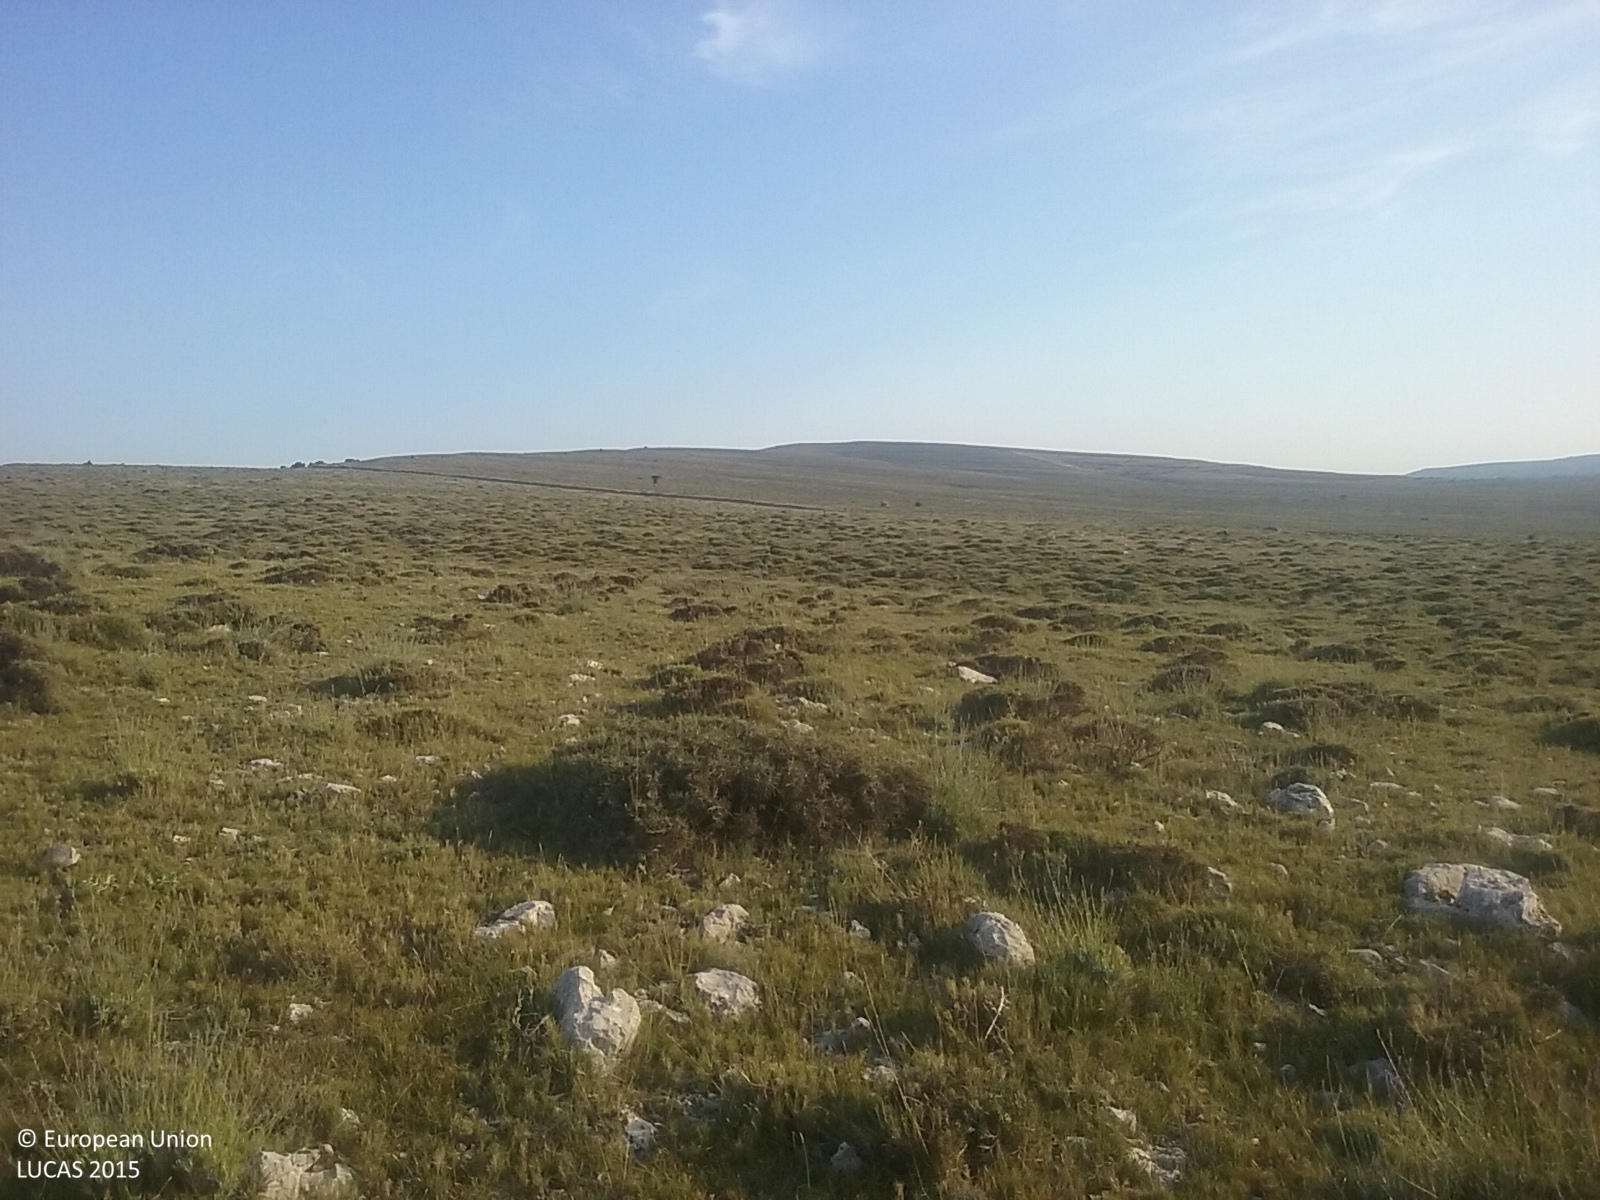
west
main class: Shrubland
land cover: Shrubland without tree cover
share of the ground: 25 - 50 %
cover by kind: herbaceous plants 75 %, shrubs 25 %
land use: Agriculture (excluding fallow land and kitchen gardens)
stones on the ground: 25 - 50 %
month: August
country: ES
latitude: 40.4972
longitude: -0.0471
